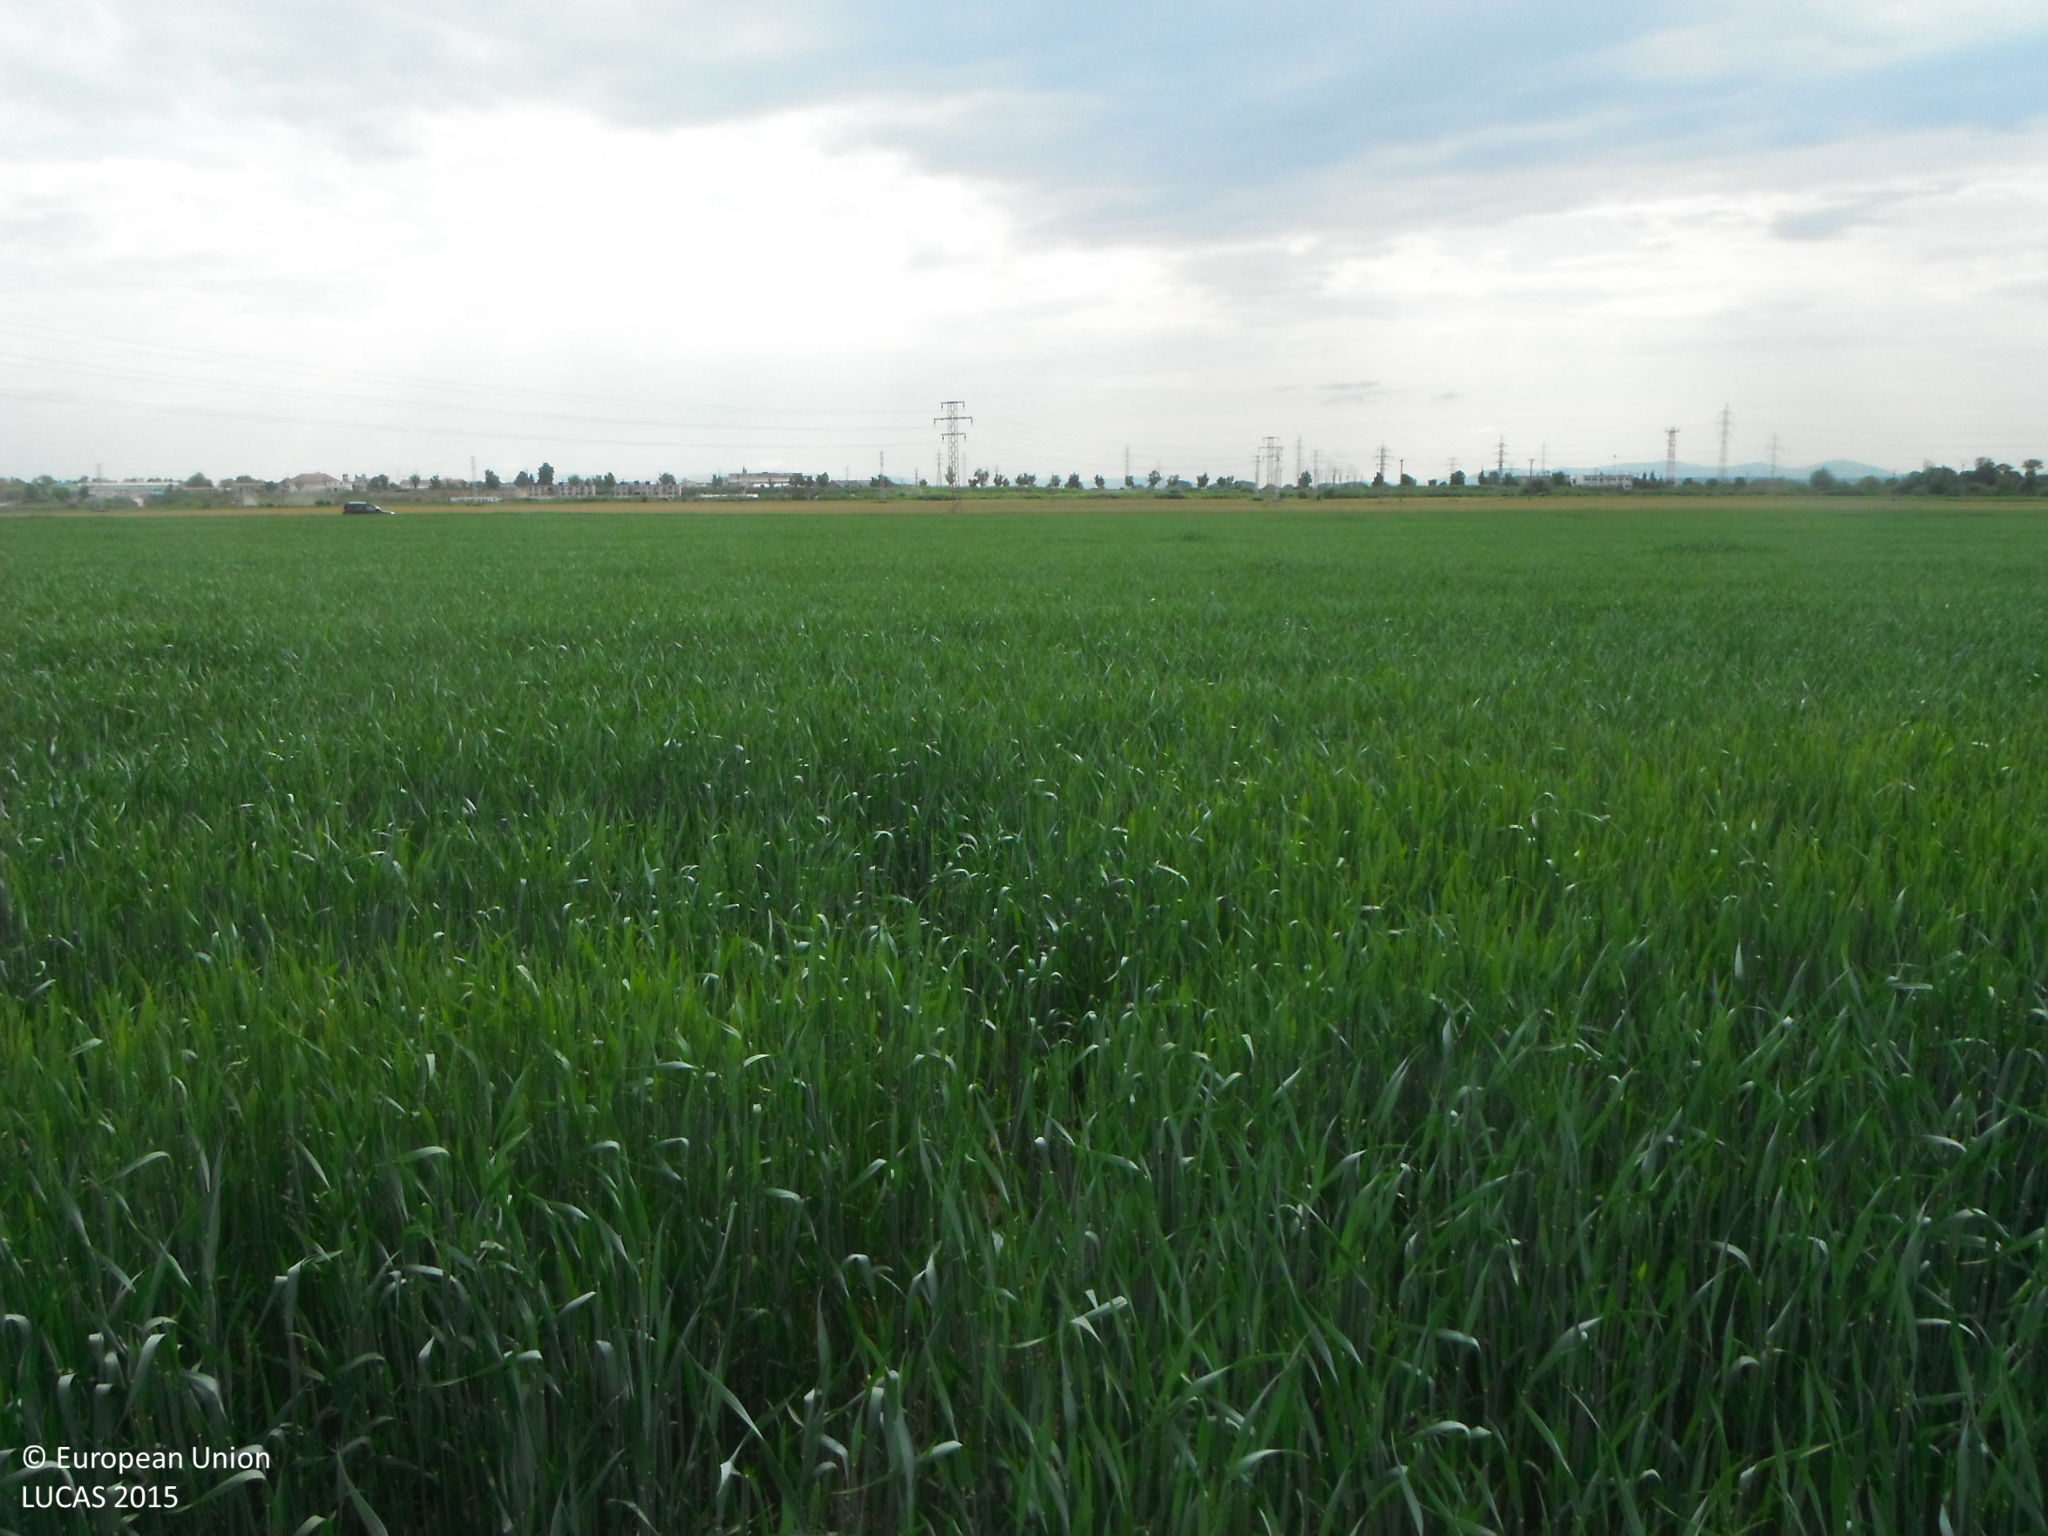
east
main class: Cropland
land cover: Common wheat
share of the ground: > 75 %
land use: Agriculture (excluding fallow land and kitchen gardens)
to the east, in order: Common wheat; Electric lines; Common wheat; Maize
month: May
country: SK
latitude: 48.5989
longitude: 20.9838
